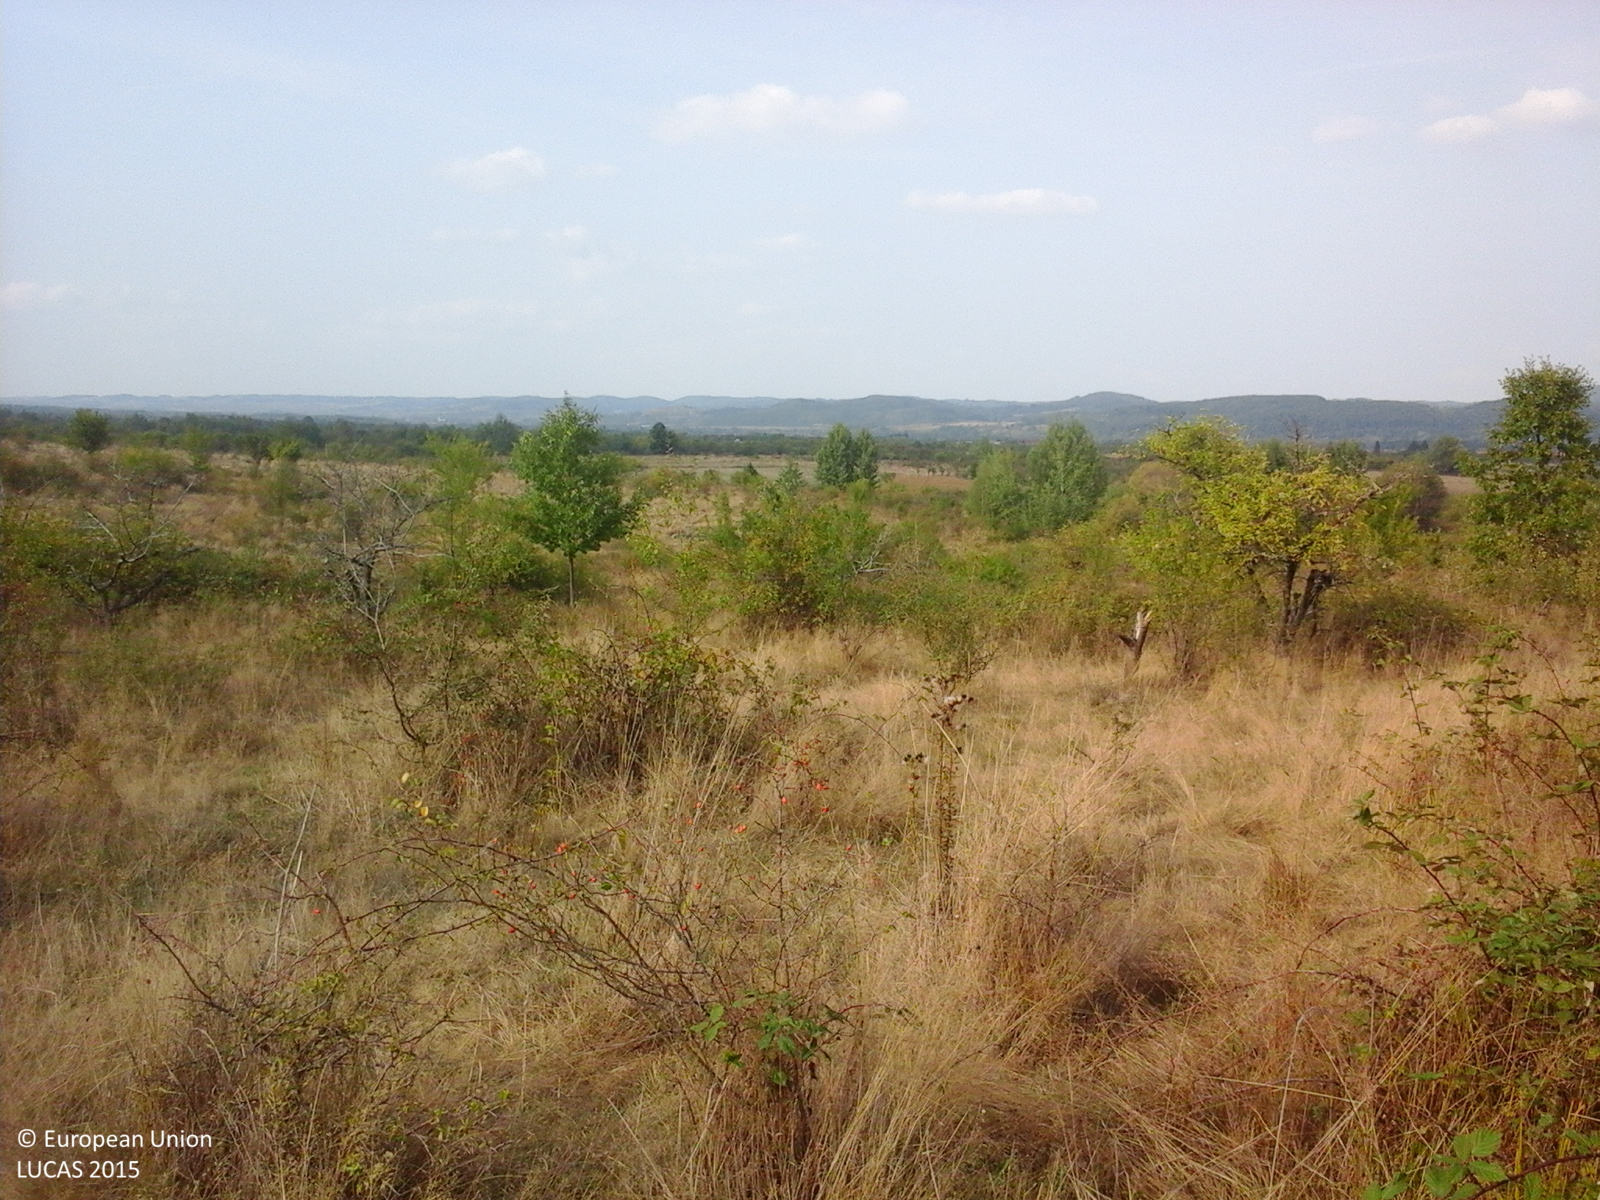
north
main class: Cropland
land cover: Other fruit trees and berries
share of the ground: 50 - 75 %
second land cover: Spontaneously vegetated surfaces
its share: > 75 %
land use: Agriculture (excluding fallow land and kitchen gardens)
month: September
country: RO
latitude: 45.4018
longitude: 21.9827
